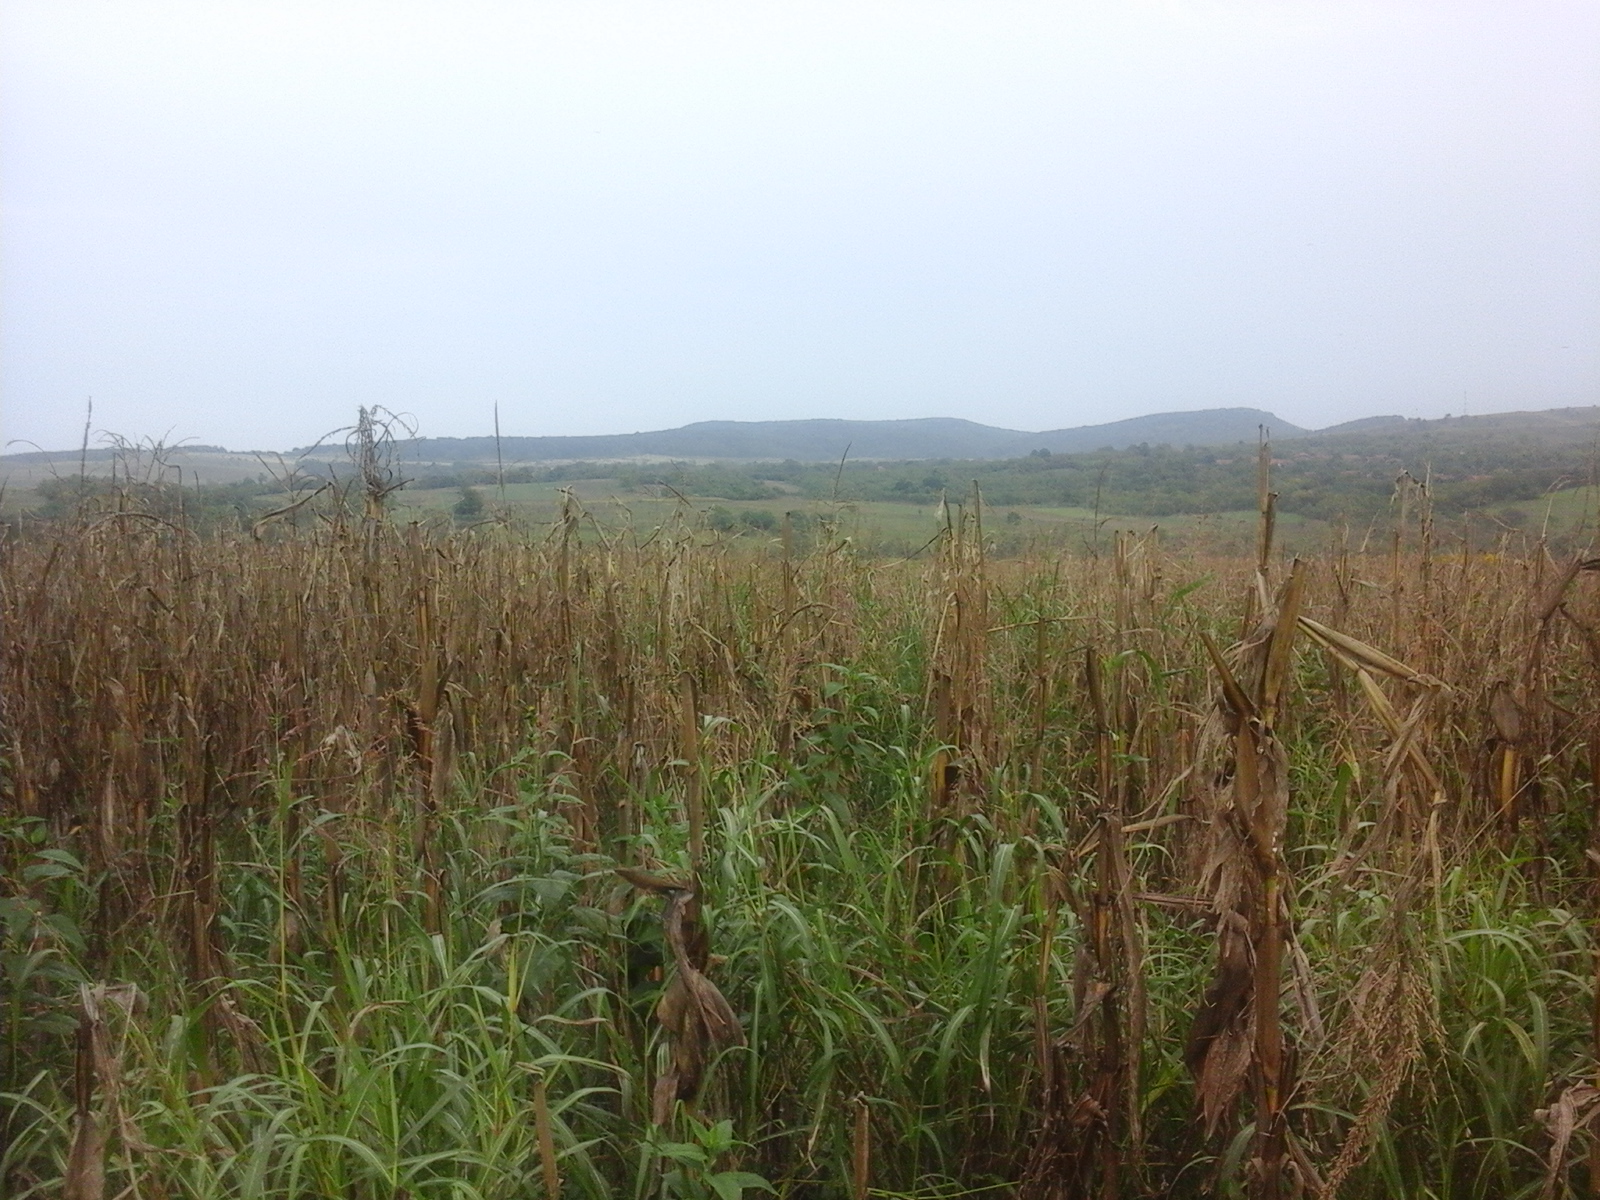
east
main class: Cropland
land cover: Maize
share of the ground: > 75 %
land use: Agriculture (excluding fallow land and kitchen gardens)
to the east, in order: Maize
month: September
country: RO
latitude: 45.7722
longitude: 23.0045
